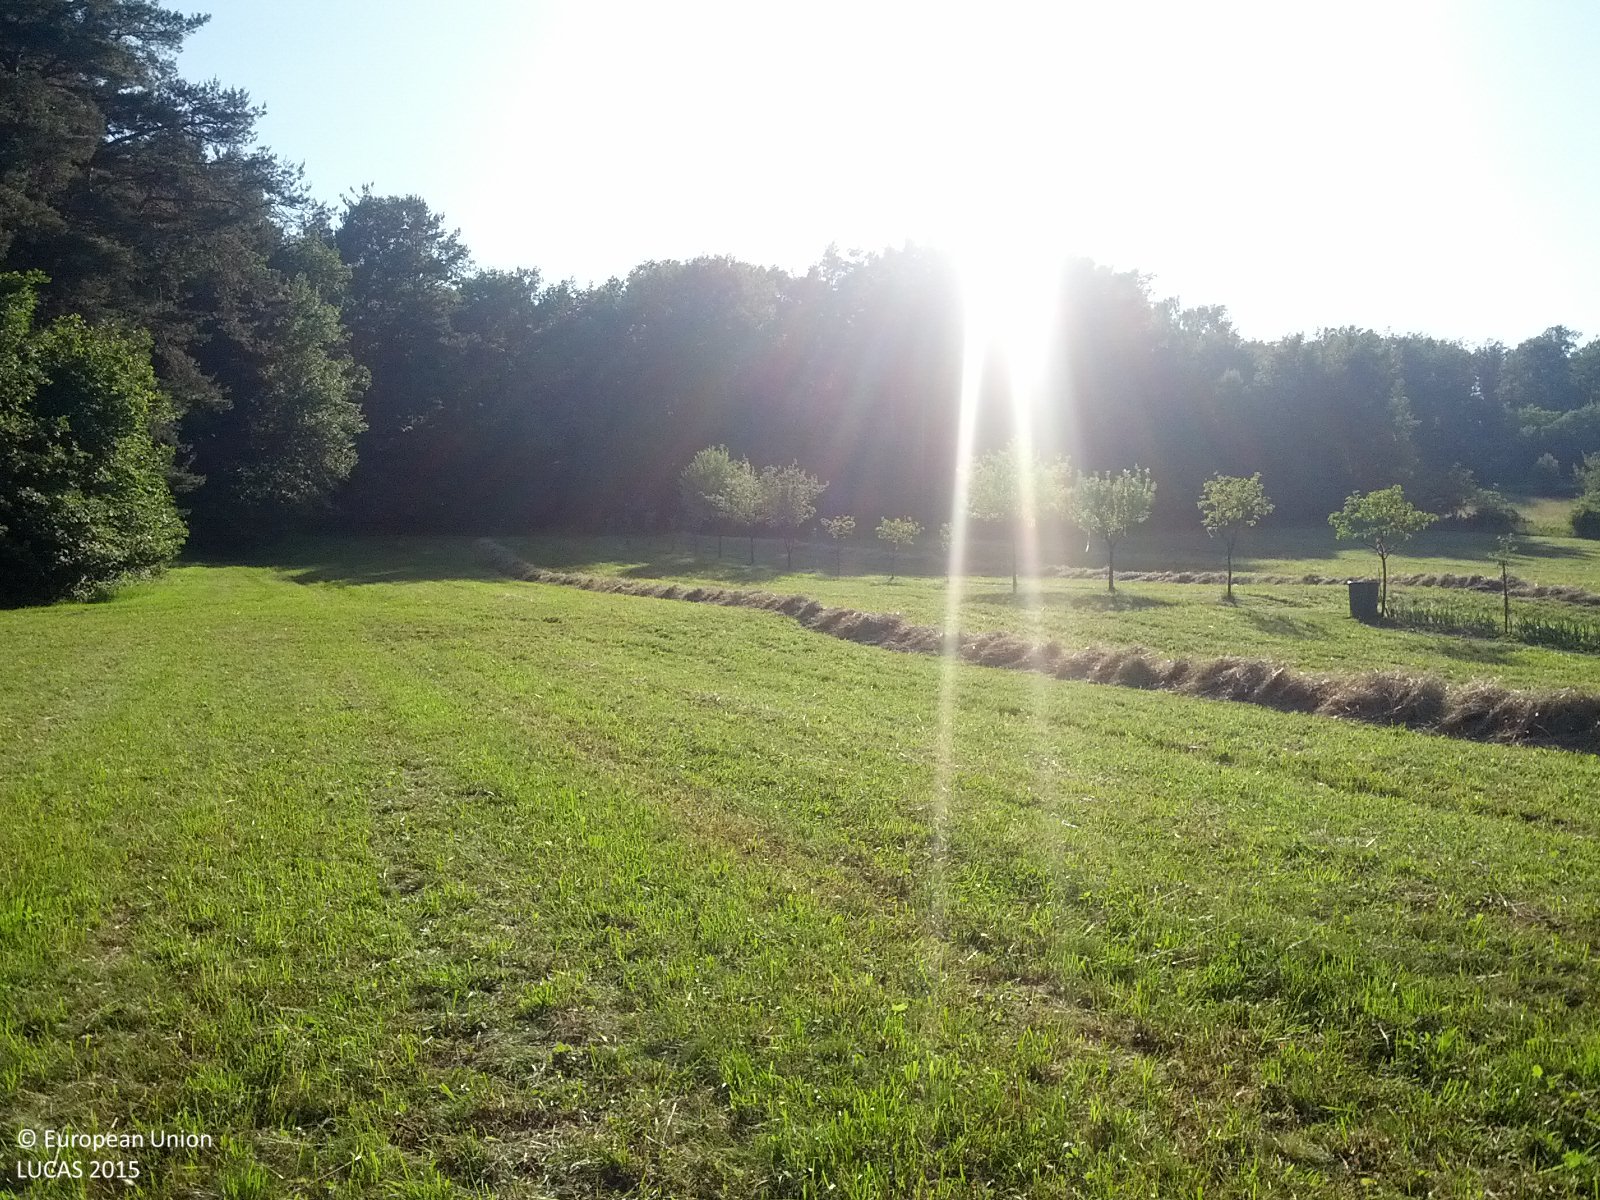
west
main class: Grassland
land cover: Grassland without tree/shrub cover
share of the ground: > 75 %
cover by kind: herbaceous plants 100 %
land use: Agriculture (excluding fallow land and kitchen gardens)
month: June
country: AT
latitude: 47.1888
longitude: 16.4035
